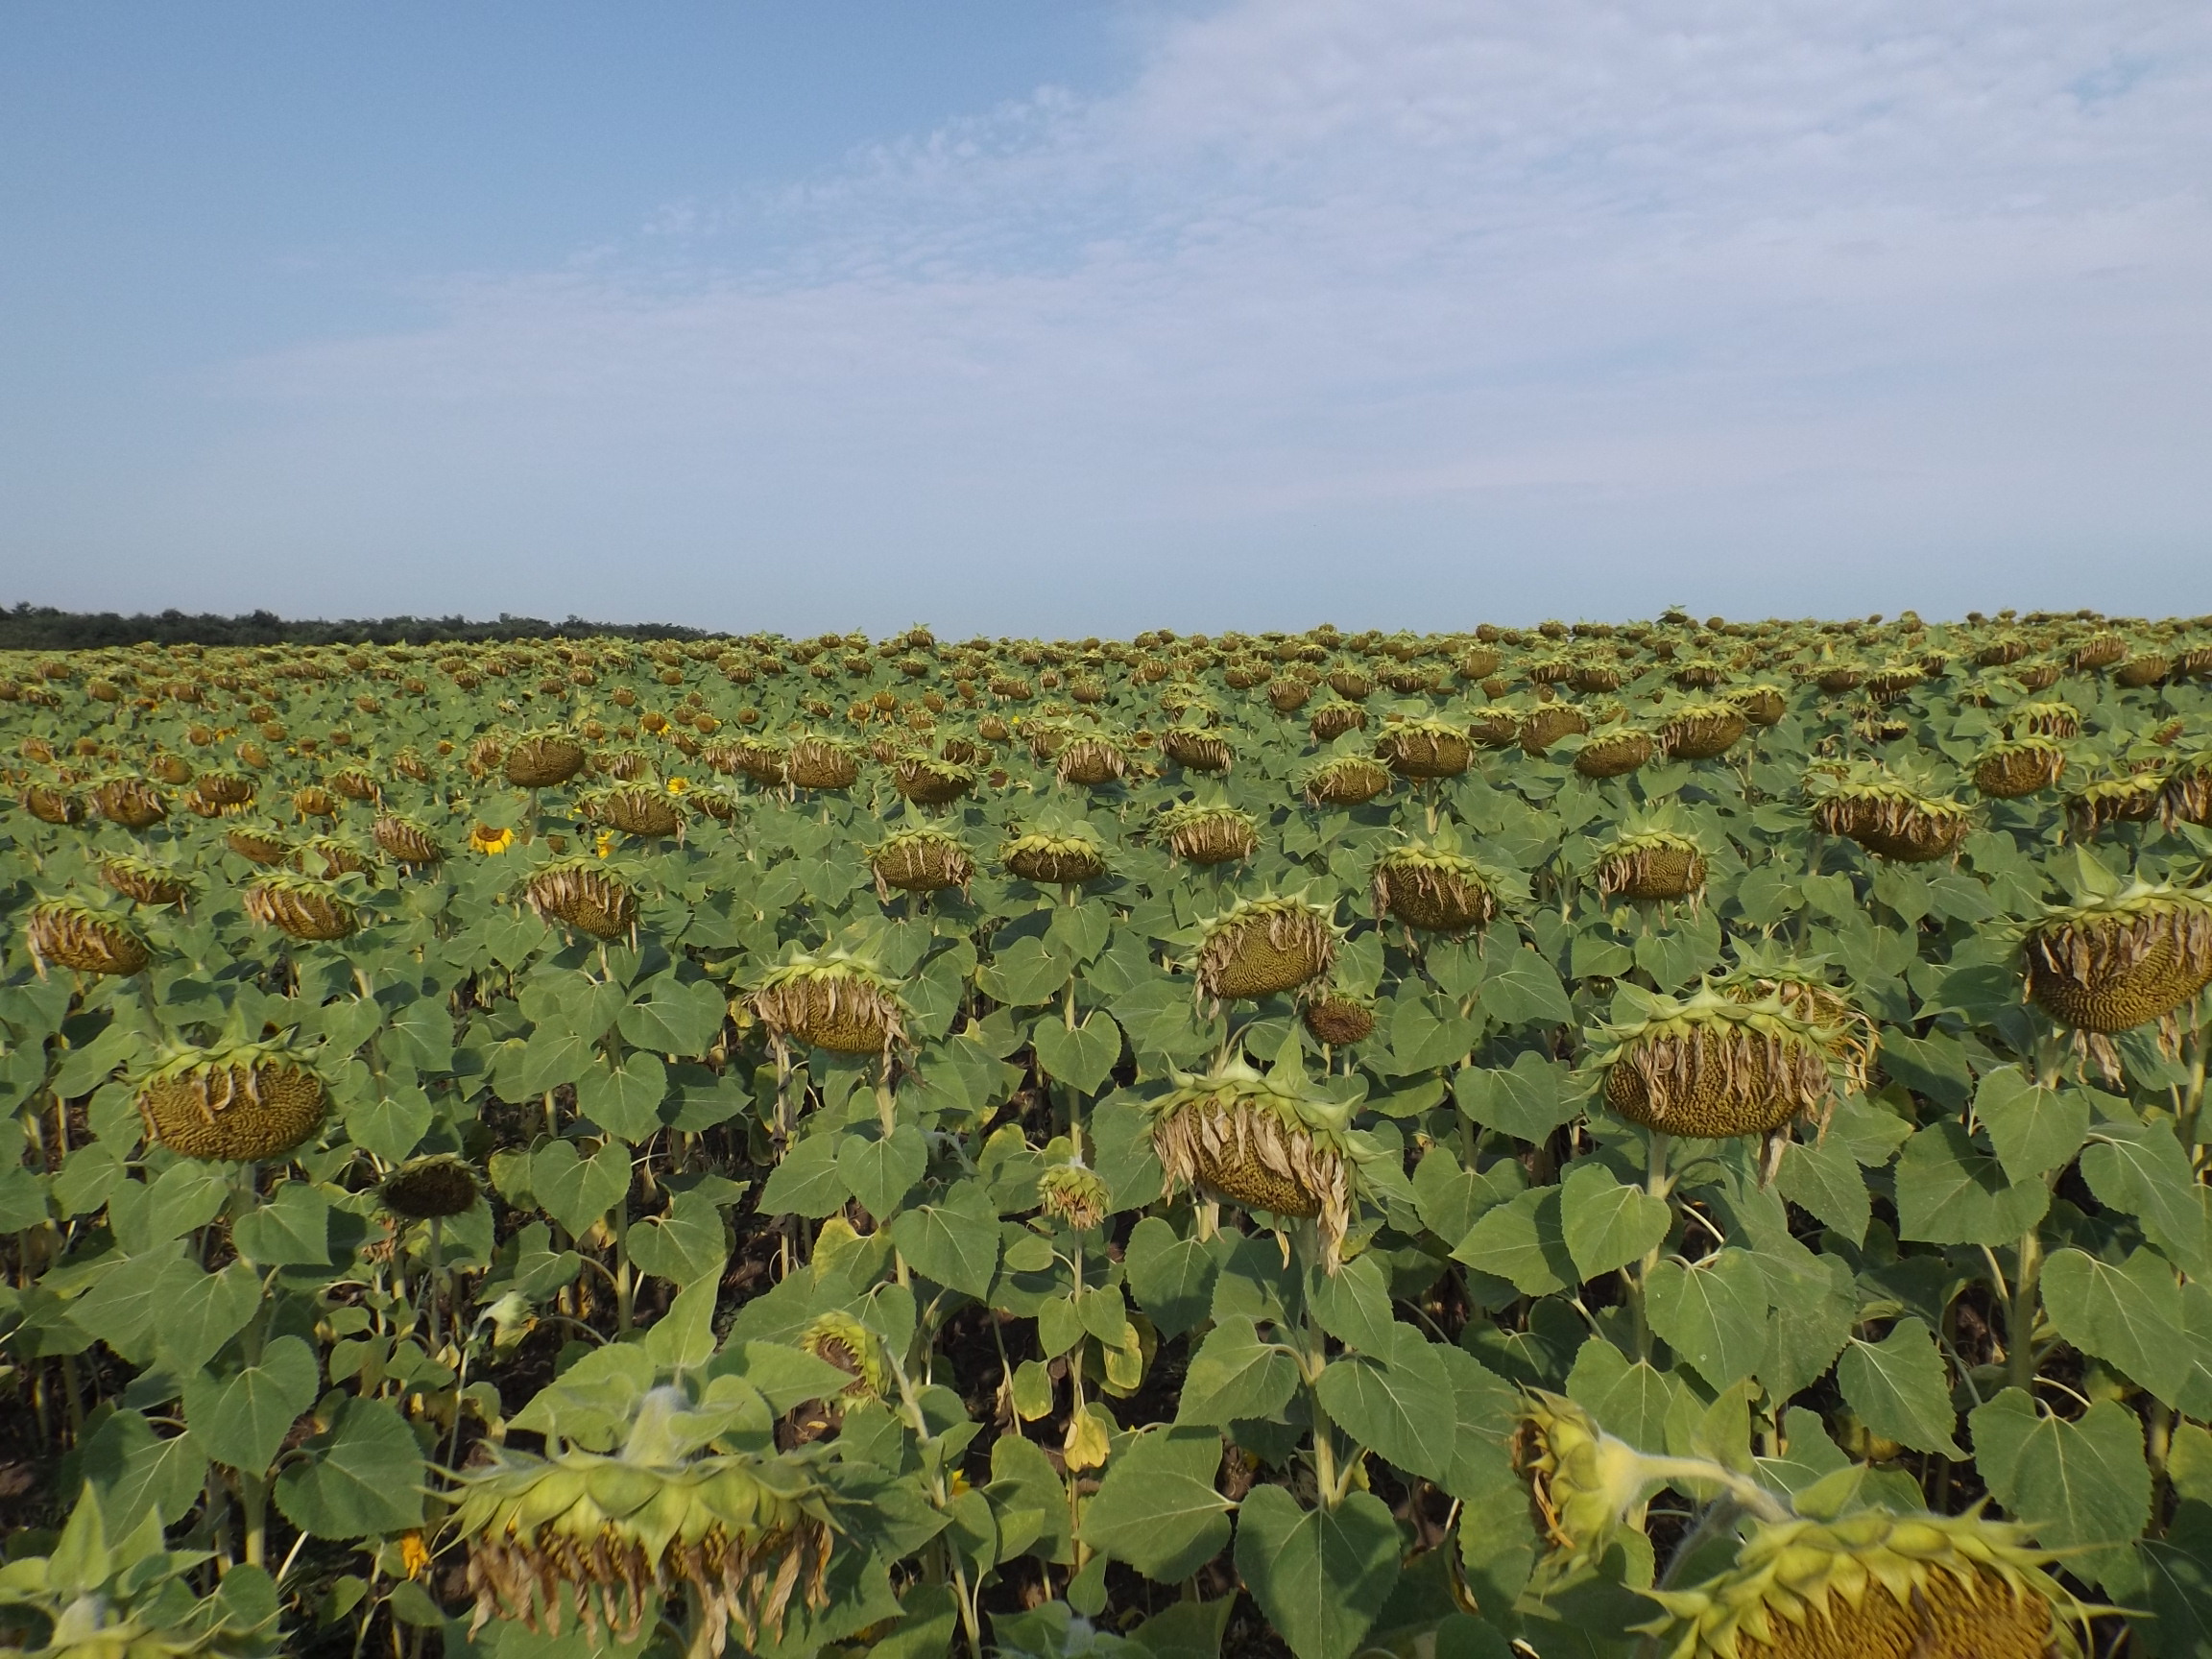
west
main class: Cropland
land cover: Sunflower
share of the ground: 50 - 75 %
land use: Agriculture (excluding fallow land and kitchen gardens)
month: July
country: BG
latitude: 43.5448
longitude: 27.4195
